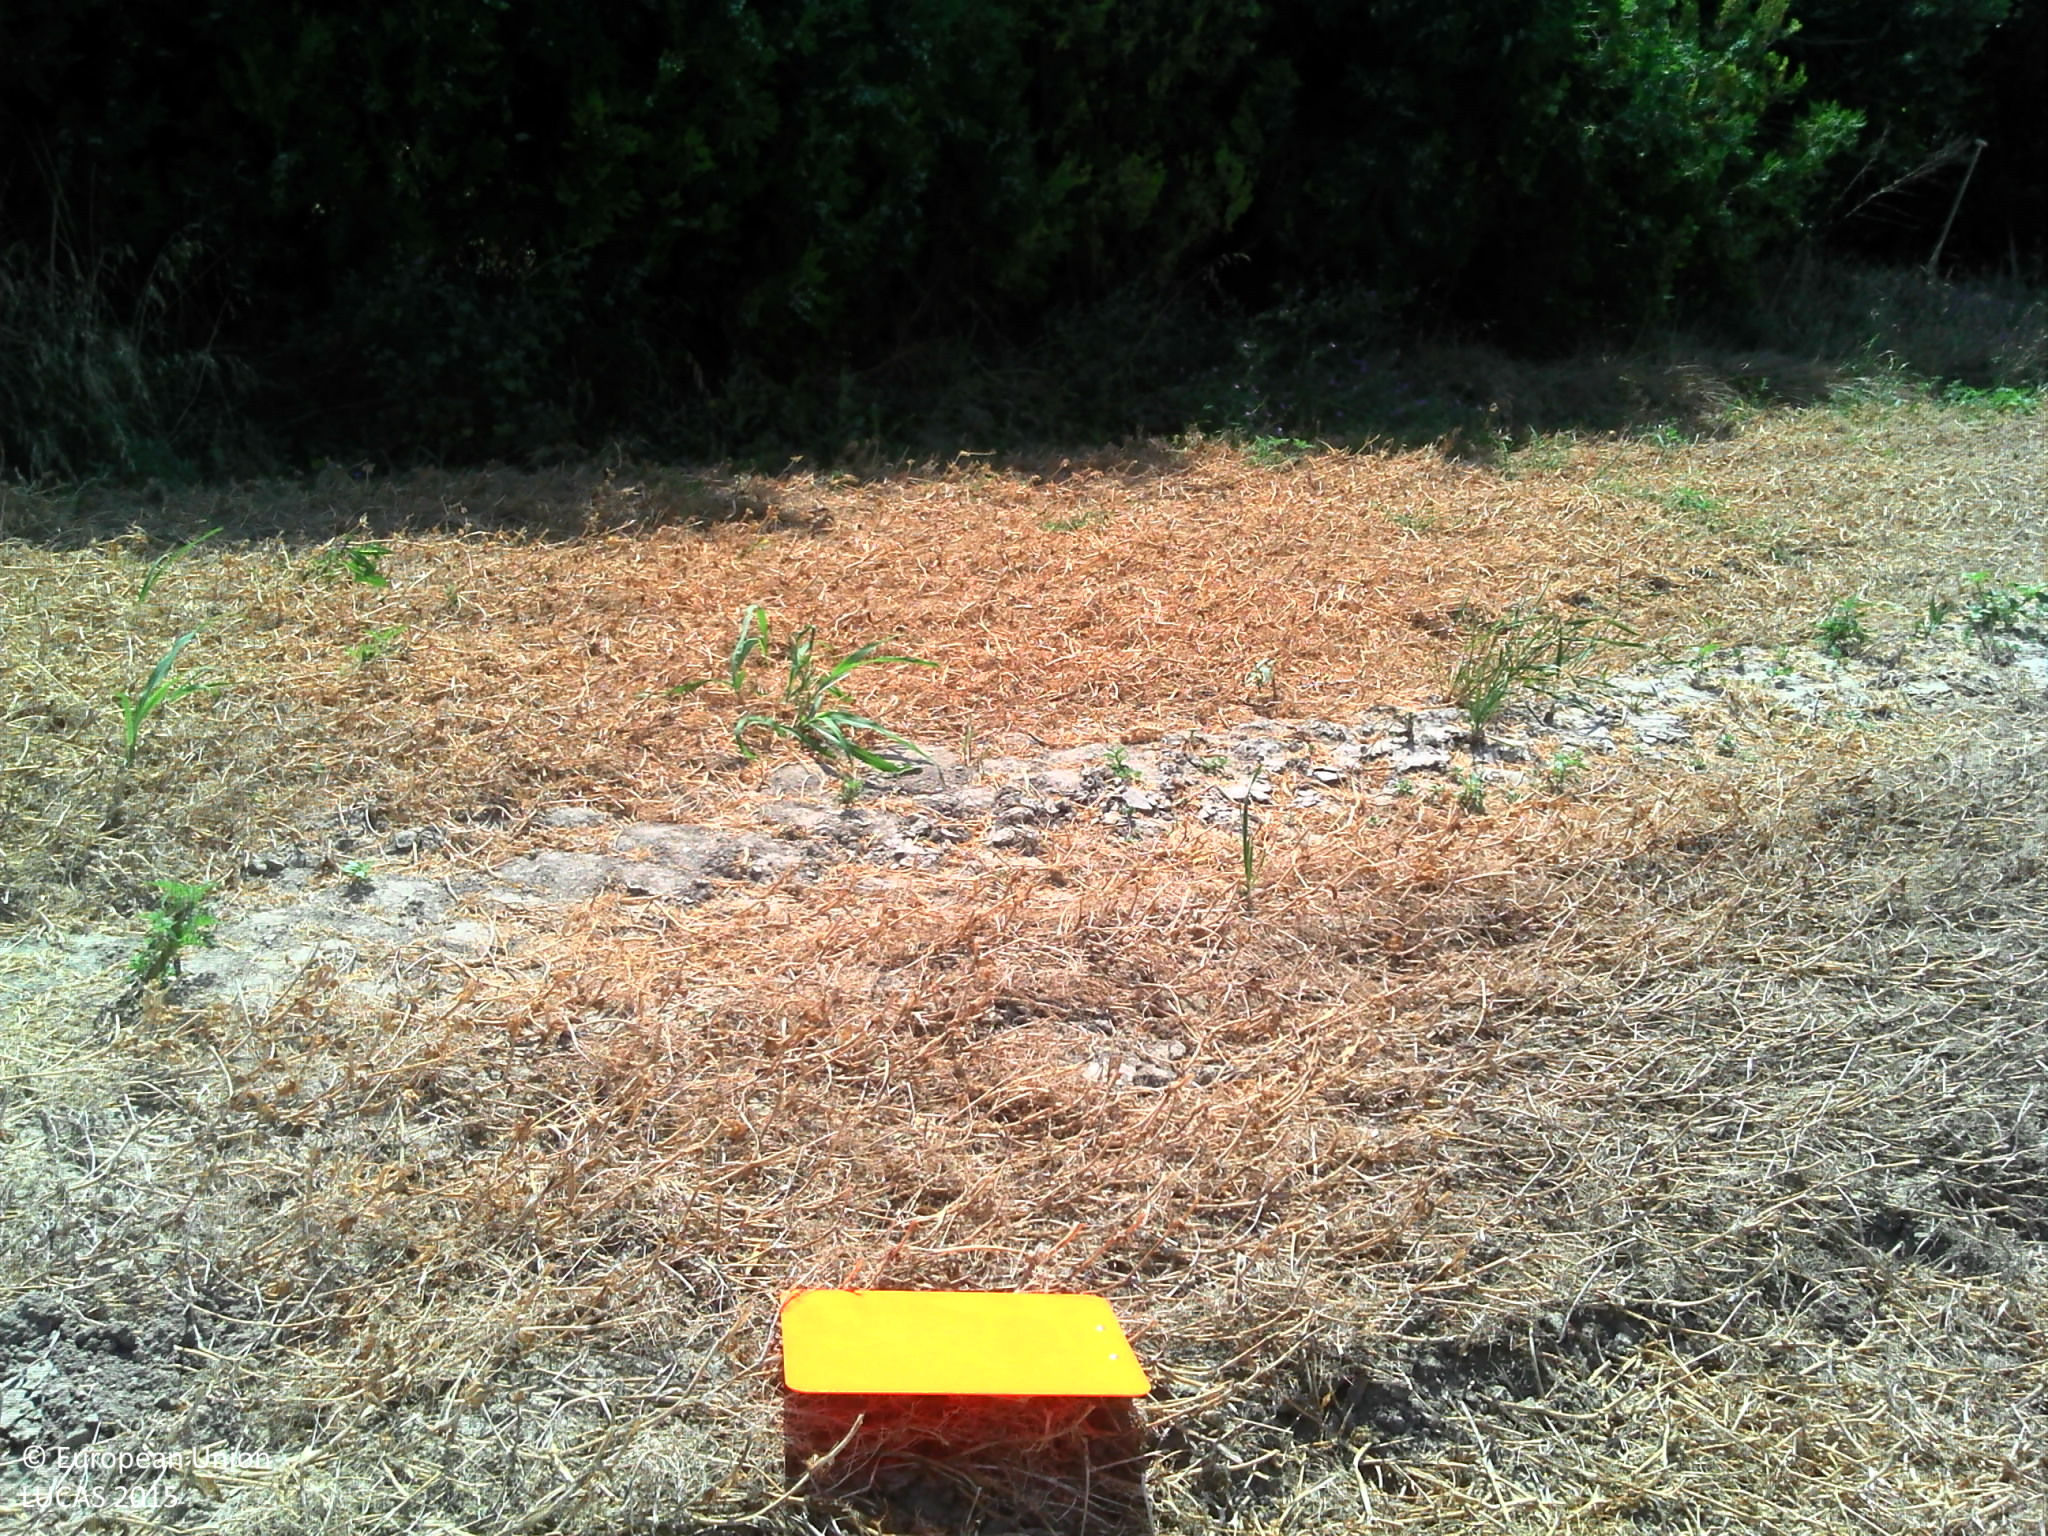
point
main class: Cropland
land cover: Dry pulses
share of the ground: > 75 %
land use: Agriculture (excluding fallow land and kitchen gardens)
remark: Harvested field
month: July
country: FR
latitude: 44.4136
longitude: 4.6949
